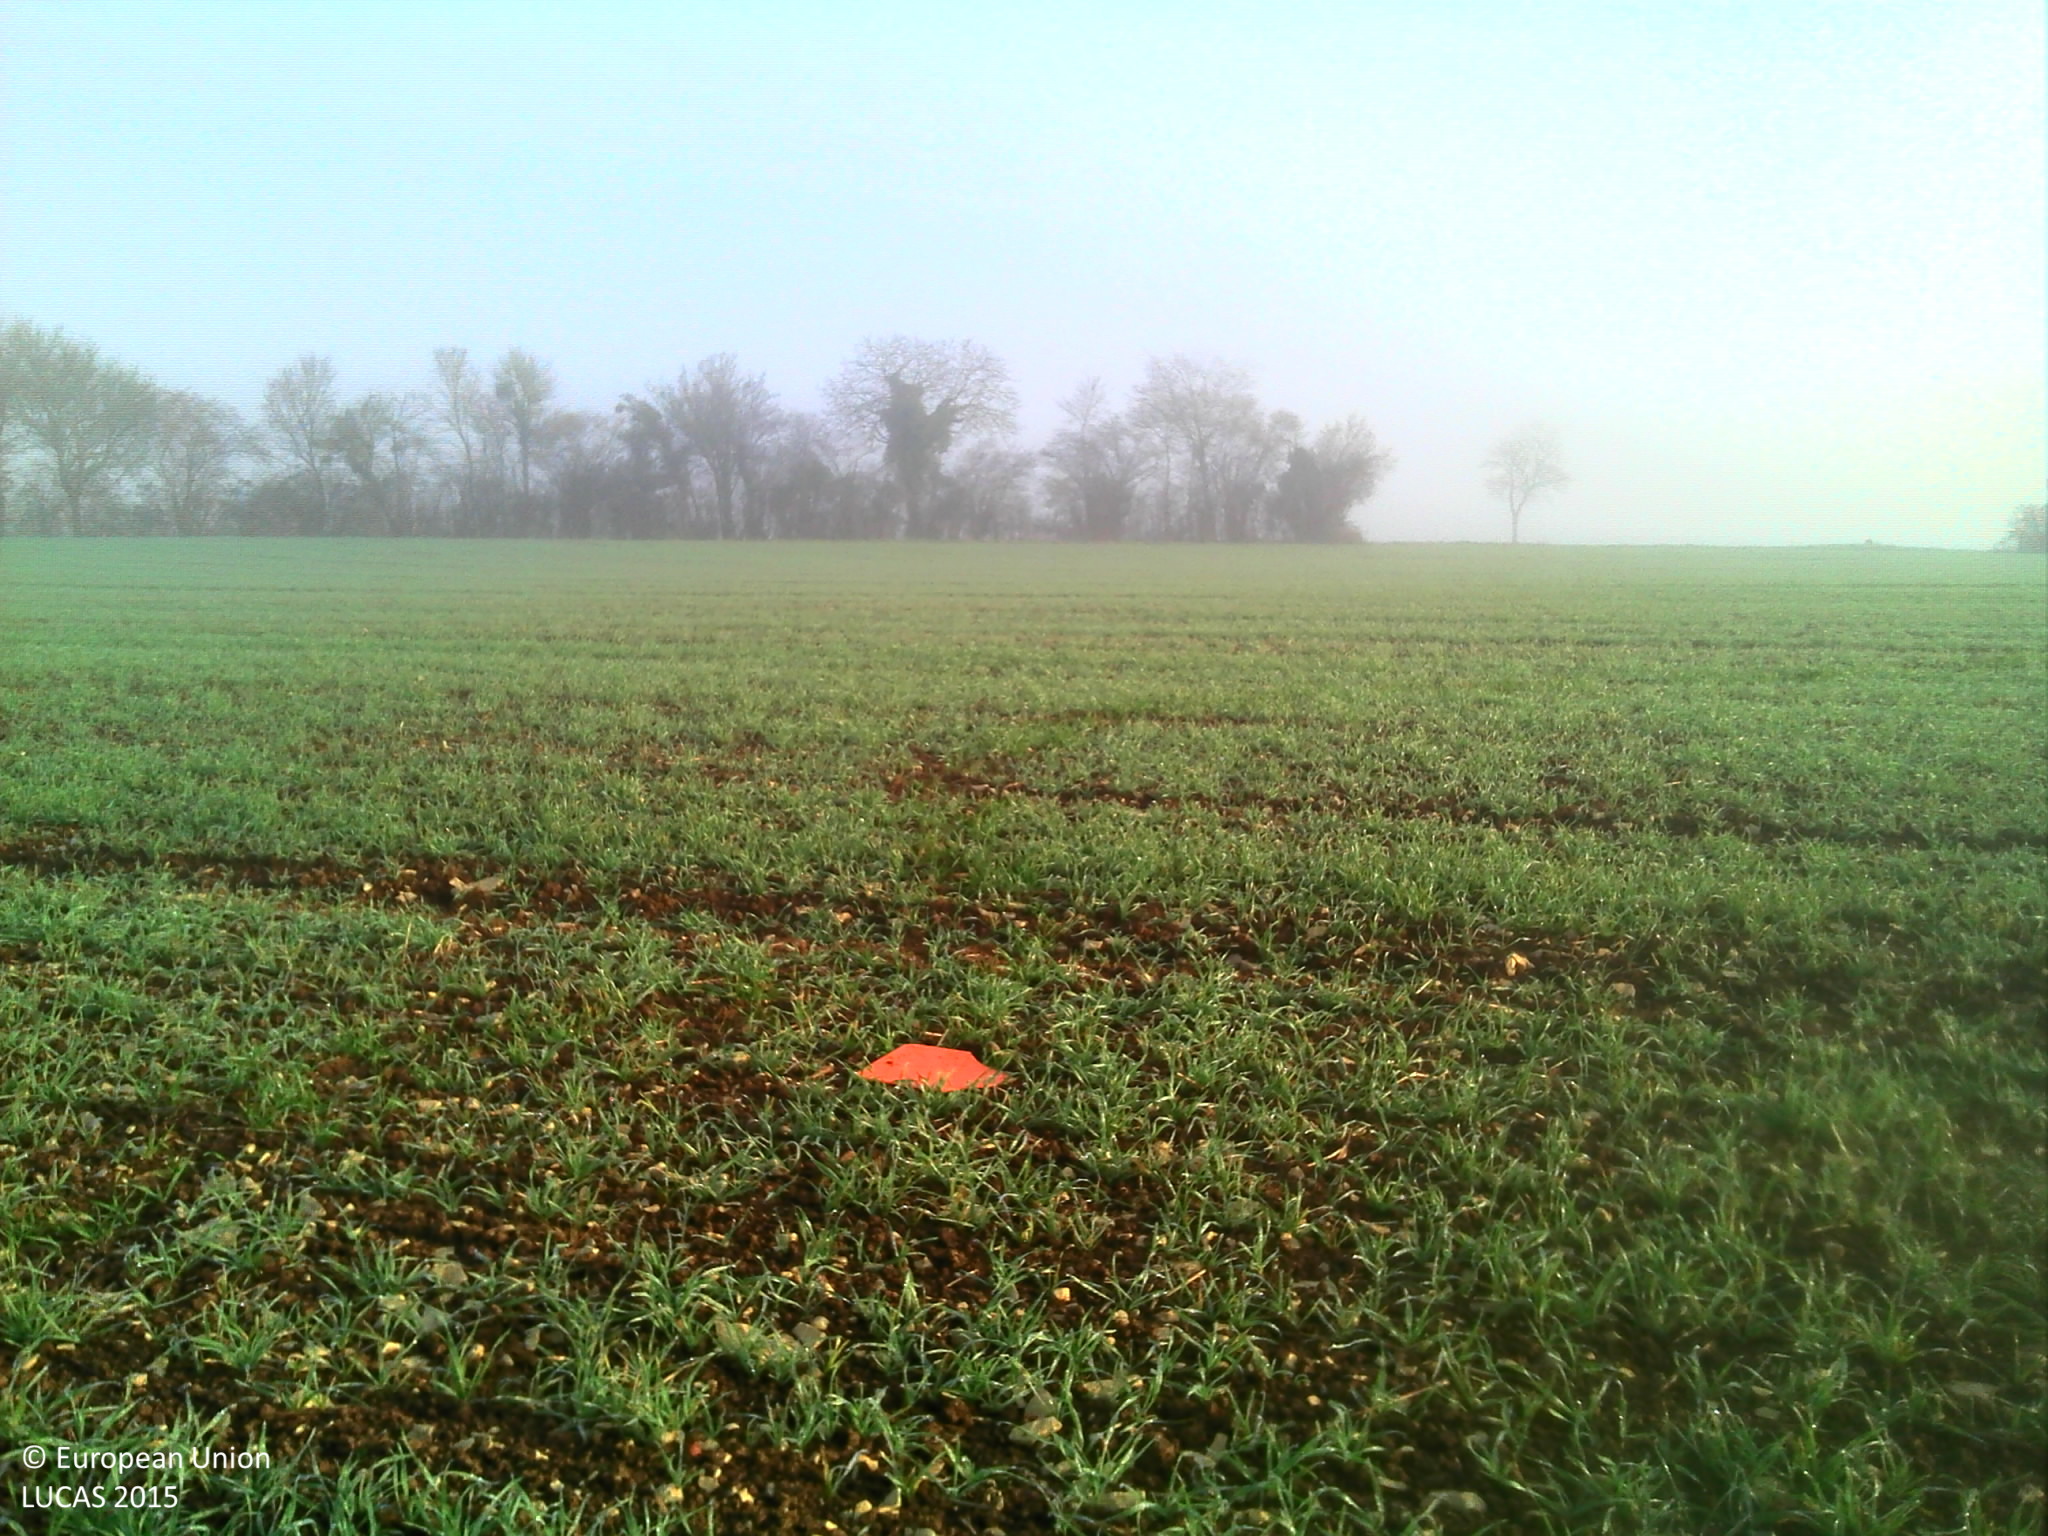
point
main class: Cropland
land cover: Common wheat
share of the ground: > 75 %
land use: Agriculture (excluding fallow land and kitchen gardens)
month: December
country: FR
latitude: 47.4889
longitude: 3.1863
